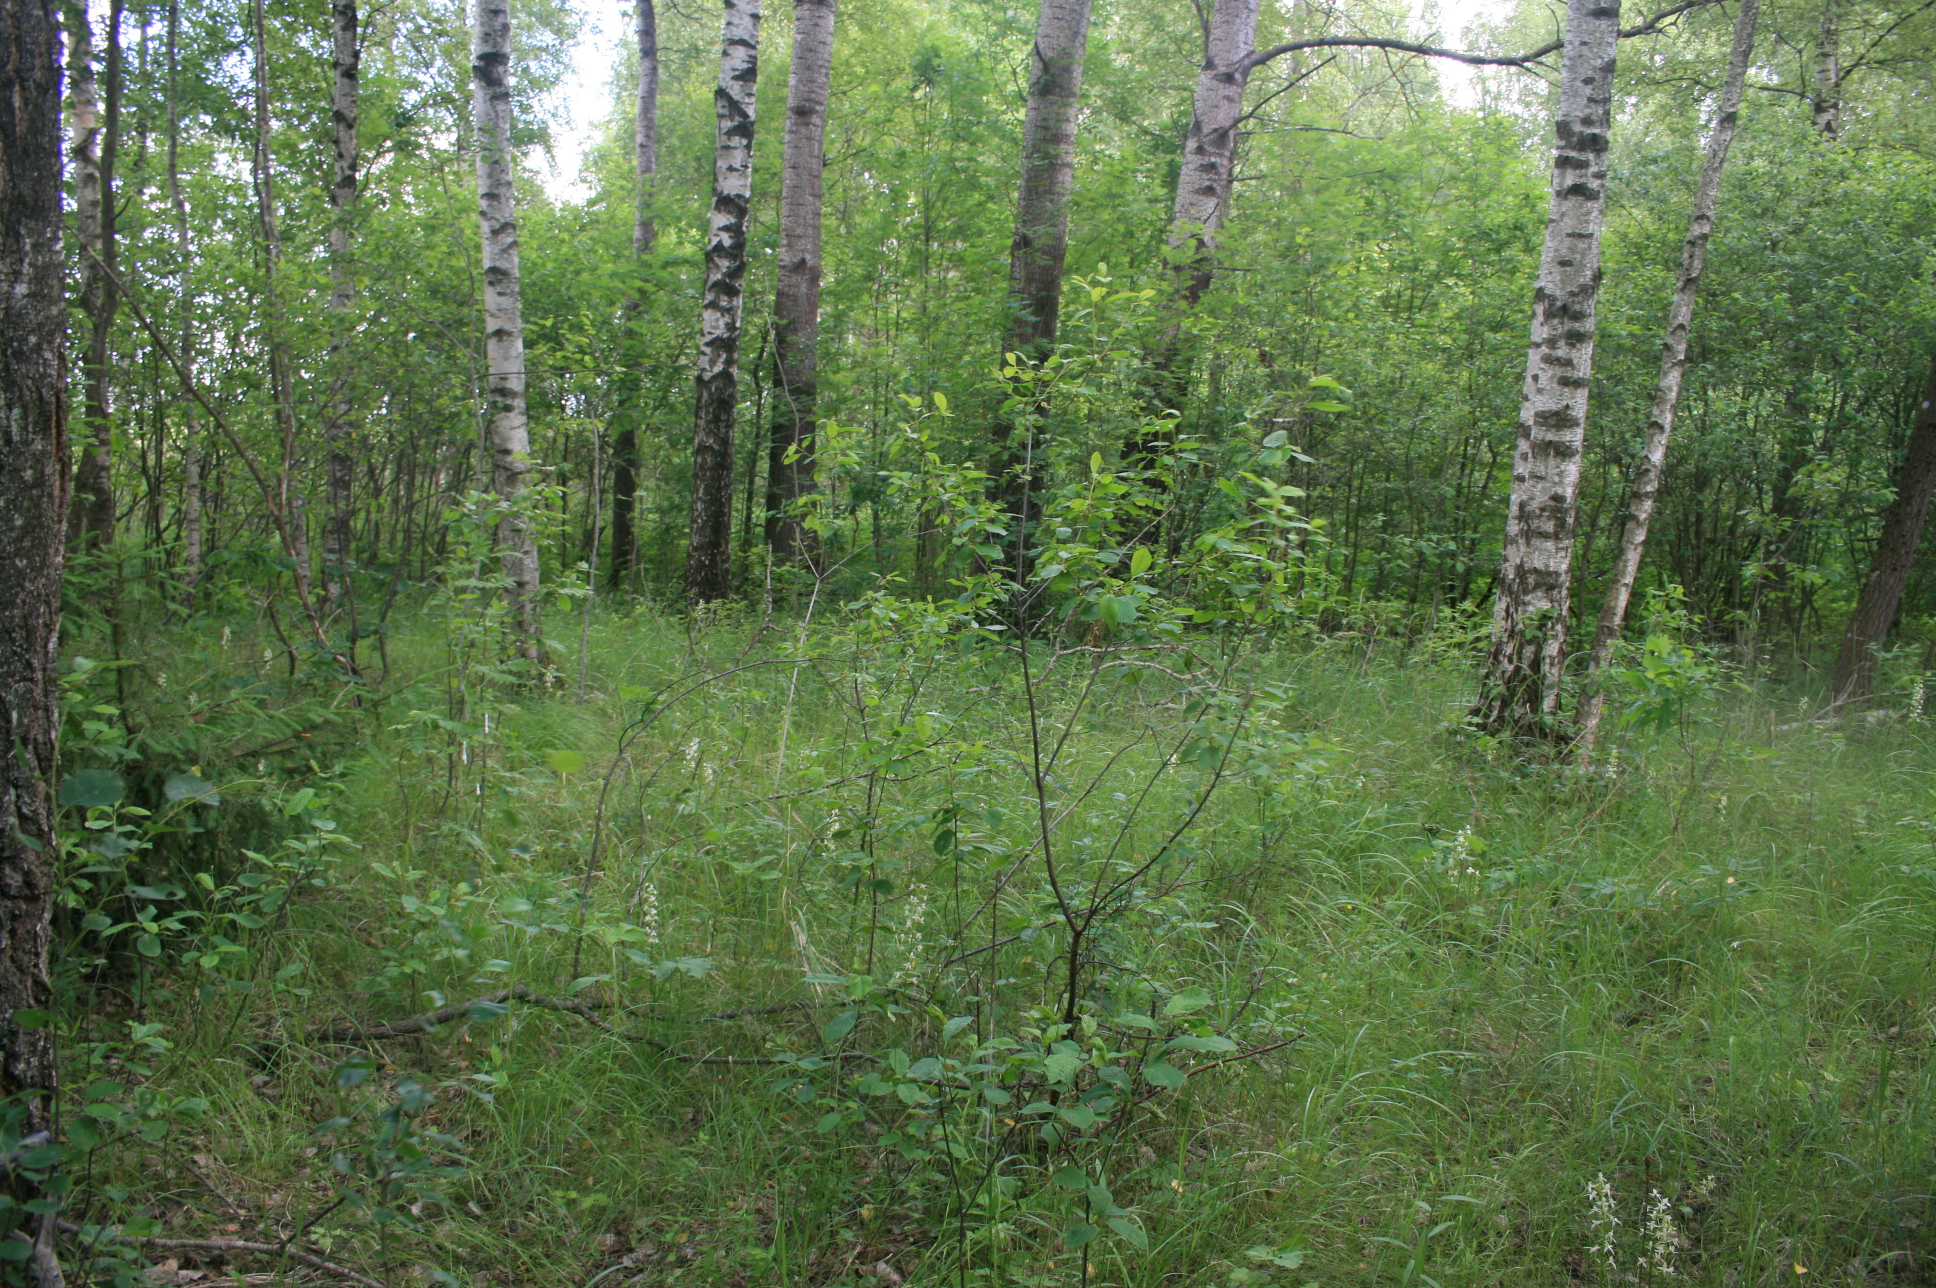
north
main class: Woodland
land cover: Broadleaved woodland
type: non-riverine alder, birch or aspen forest
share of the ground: > 75 %
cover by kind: broadleaved forest trees 90 %, herbaceous plants 10 %
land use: Forestry
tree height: > 5 m
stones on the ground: < 10 %
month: June
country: LT
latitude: 55.3324
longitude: 21.7945
